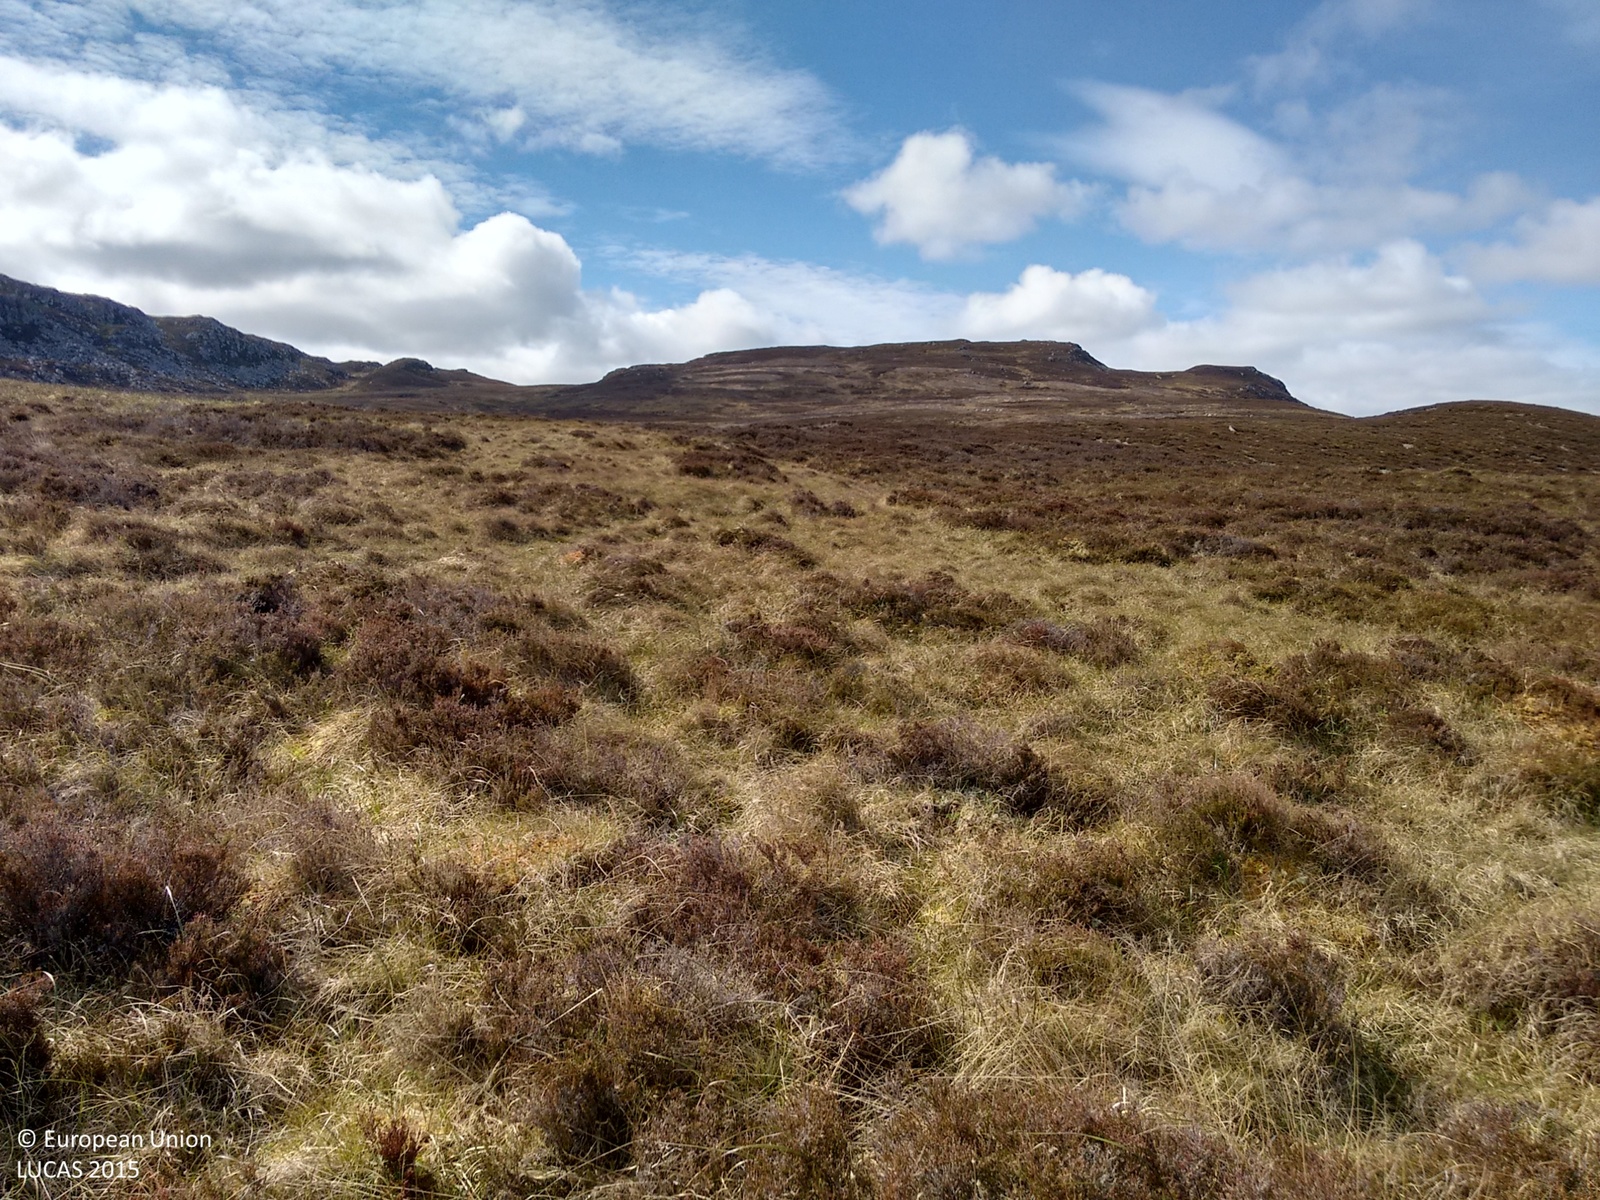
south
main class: Shrubland
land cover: Shrubland without tree cover
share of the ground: > 75 %
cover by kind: shrubs 50 %, herbaceous plants 40 %, lichens and mosses 10 %
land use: Agriculture (excluding fallow land and kitchen gardens)
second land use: Other primary production
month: June
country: GB
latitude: 57.3610
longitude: -3.7577
